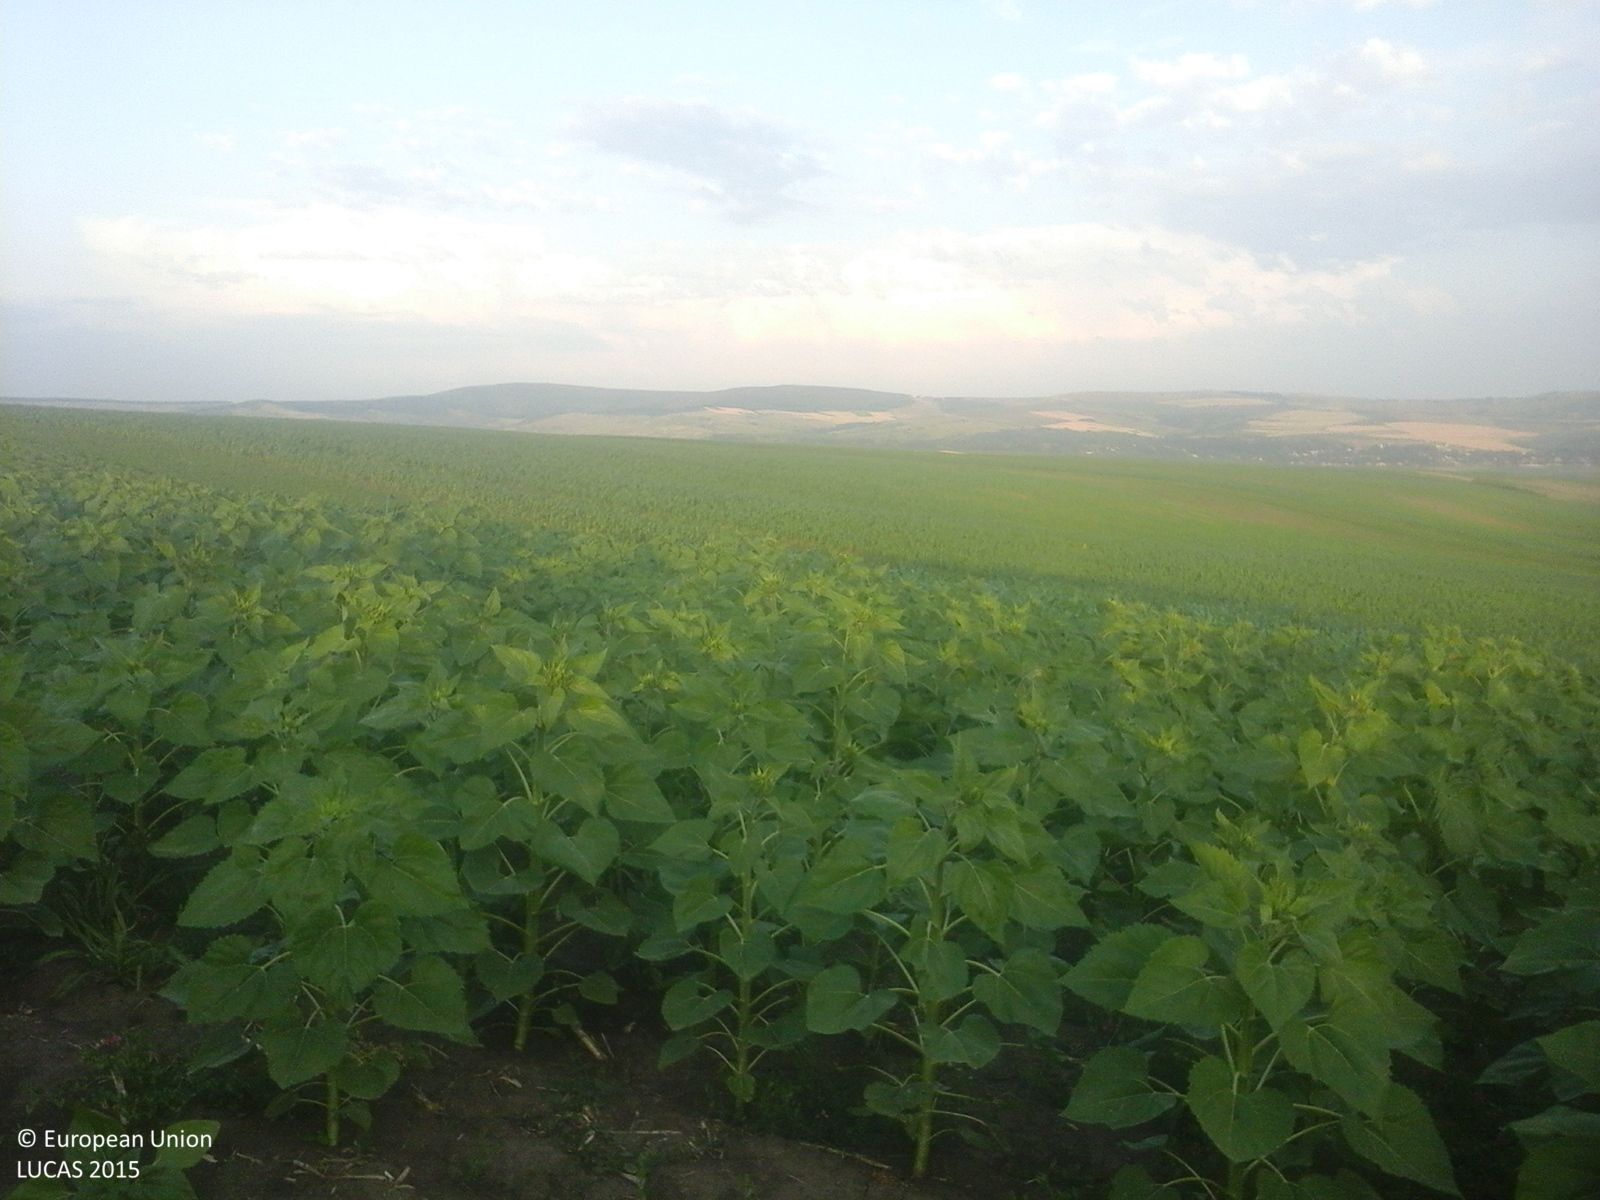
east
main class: Cropland
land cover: Sunflower
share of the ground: > 75 %
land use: Agriculture (excluding fallow land and kitchen gardens)
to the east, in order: Sunflower; Maize; Sunflower; Lucerne; Maize; Ditches and canals; Maize
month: June
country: RO
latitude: 46.7876
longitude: 27.7391
